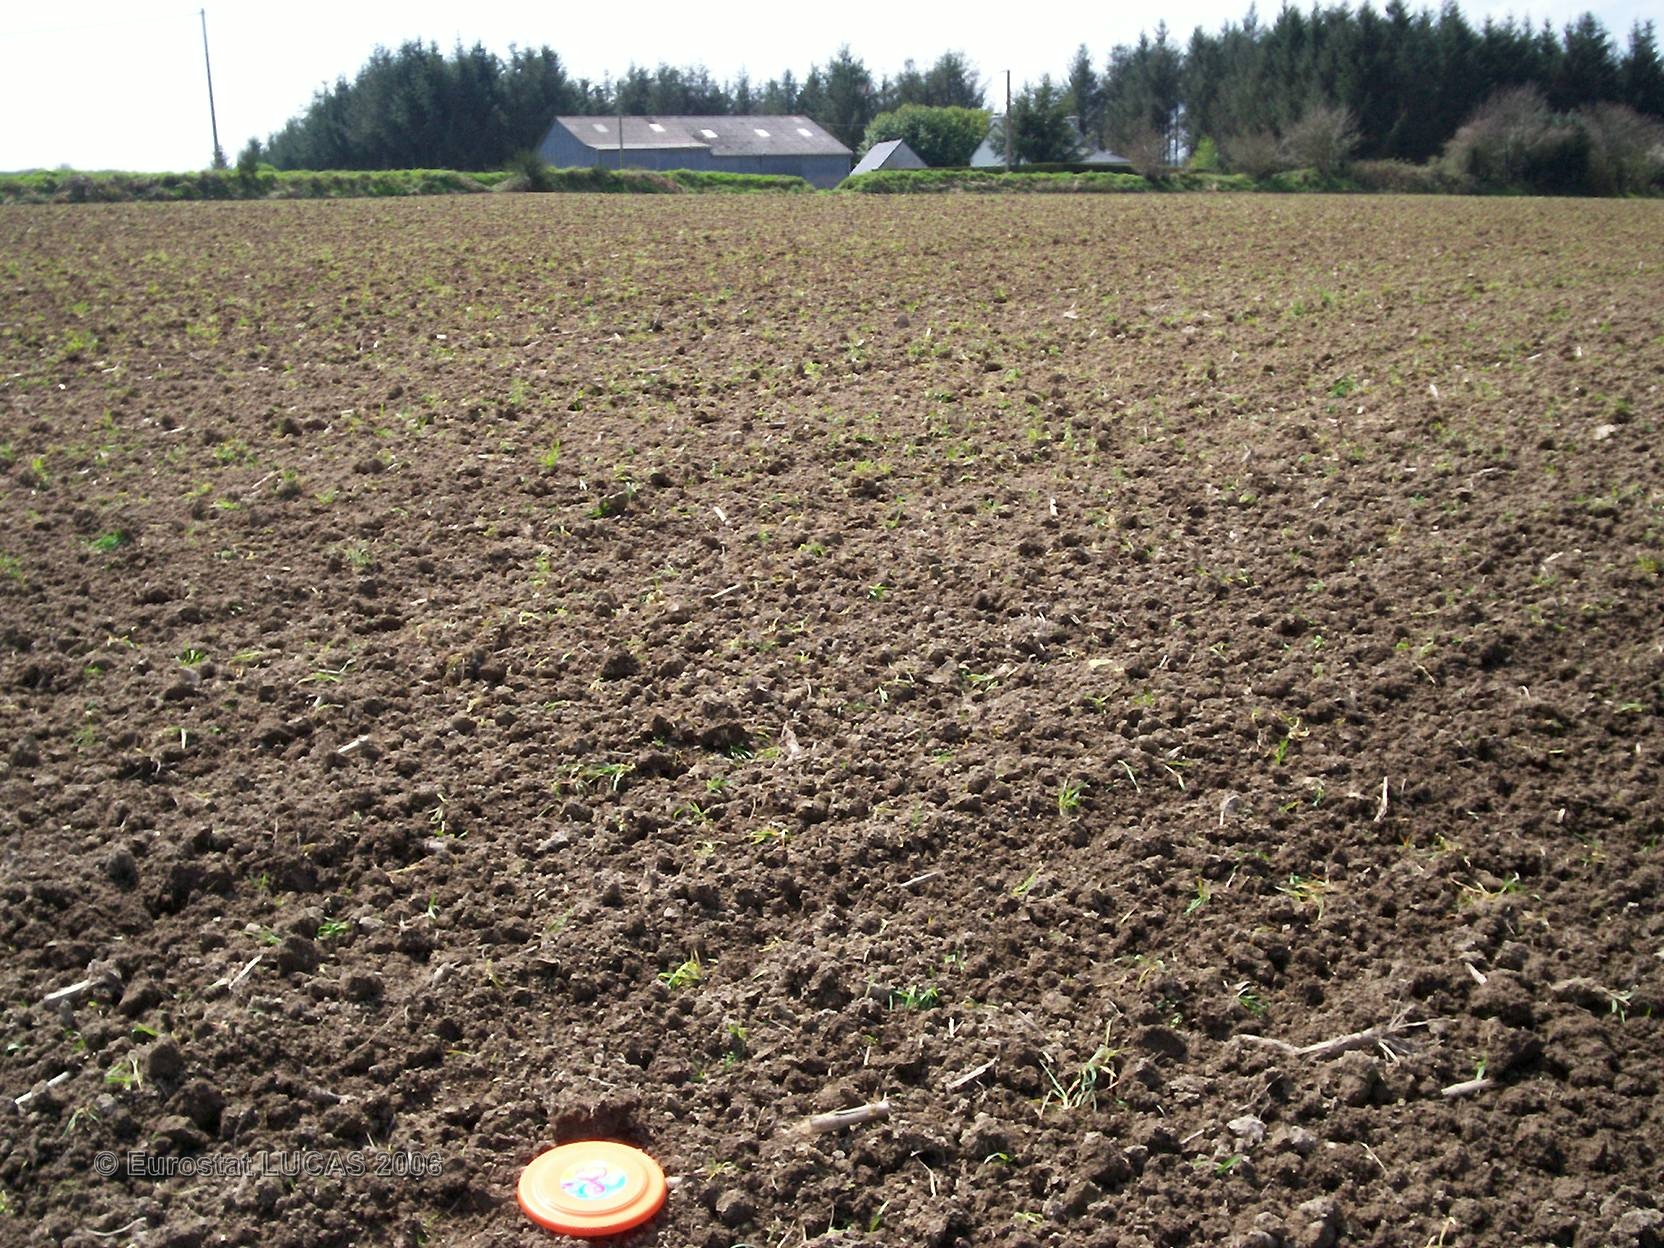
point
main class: Cropland
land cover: Maize
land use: Agriculture (excluding fallow land and kitchen gardens)
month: June
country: FR
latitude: 48.4977
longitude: -3.8212
